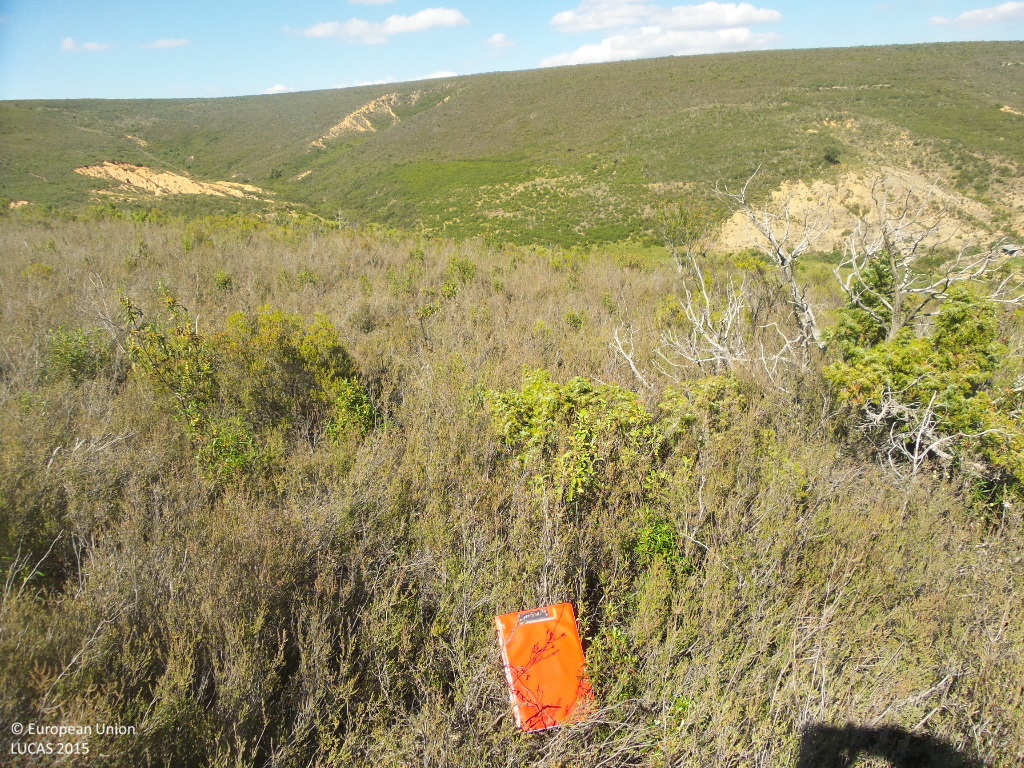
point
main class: Shrubland
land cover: Shrubland without tree cover
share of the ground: > 75 %
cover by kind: shrubs 100 %
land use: Semi-natural and natural areas not in use
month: June
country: ES
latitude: 41.1138
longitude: -3.0302
